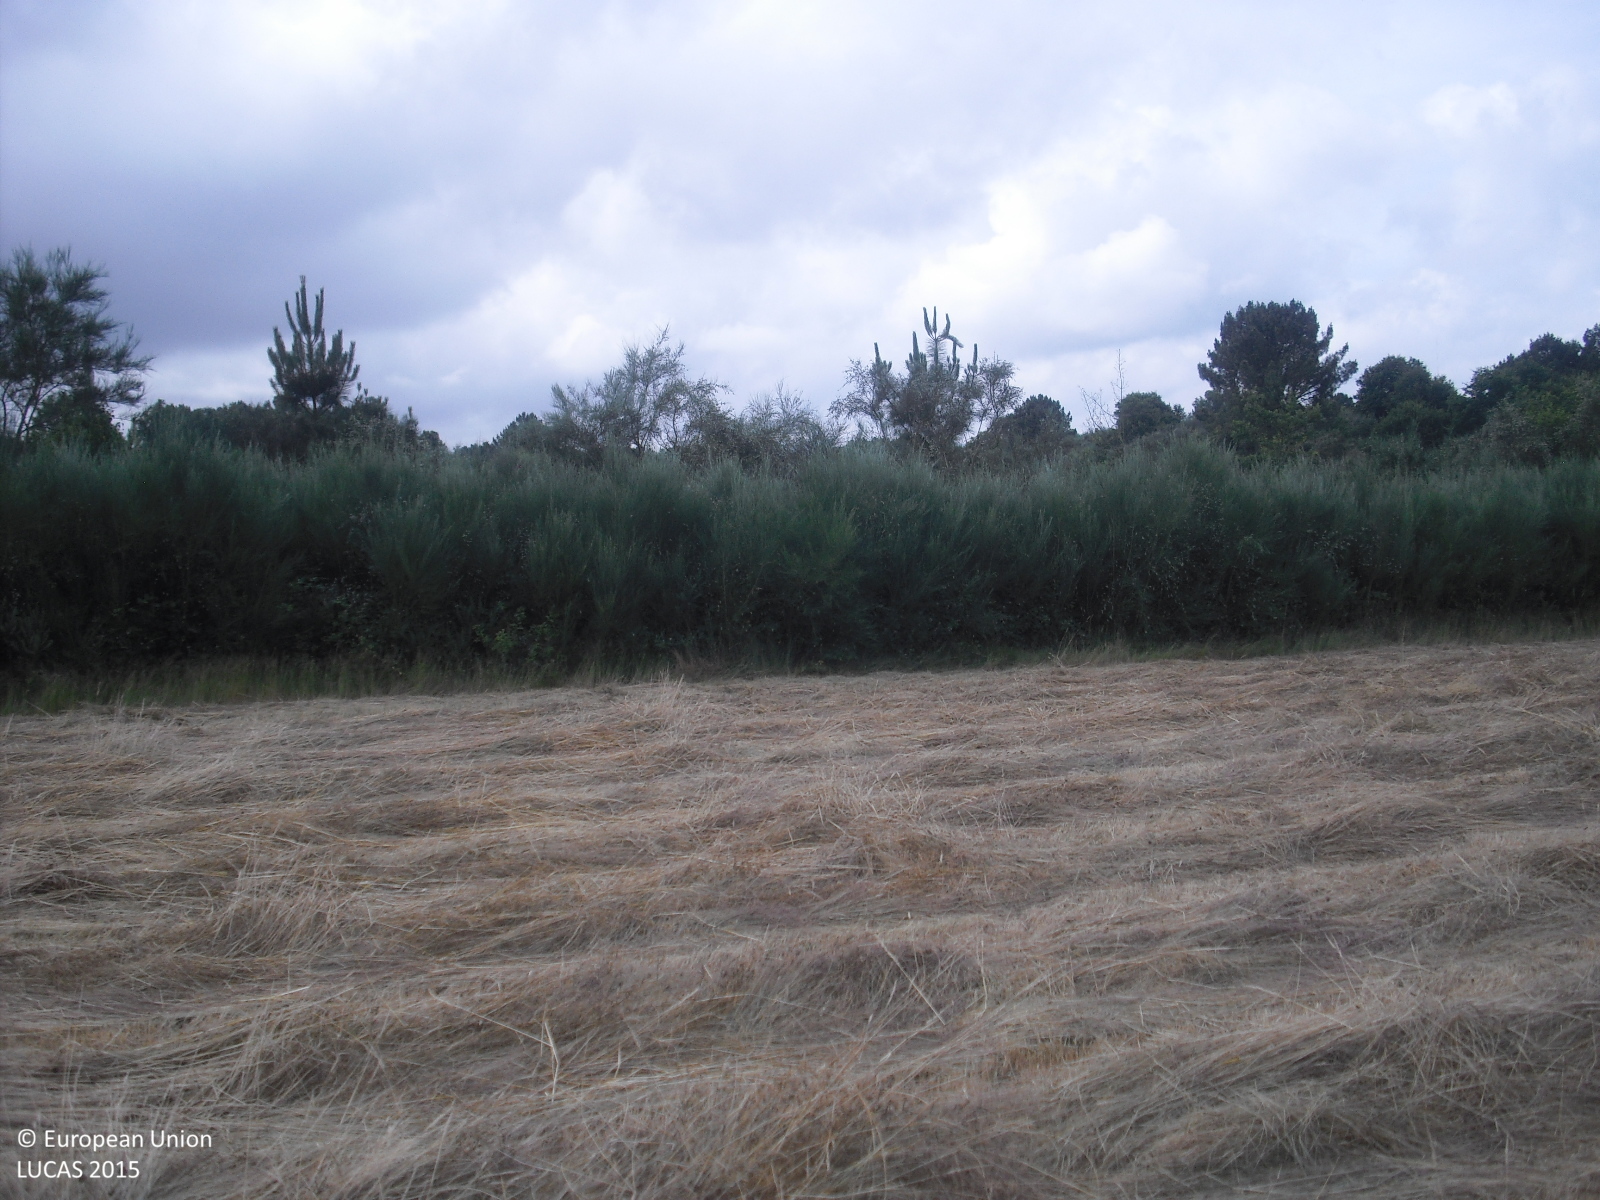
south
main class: Grassland
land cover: Grassland without tree/shrub cover
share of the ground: > 75 %
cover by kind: herbaceous plants 100 %
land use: Agriculture (excluding fallow land and kitchen gardens)
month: July
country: ES
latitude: 42.4686
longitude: -7.6725
